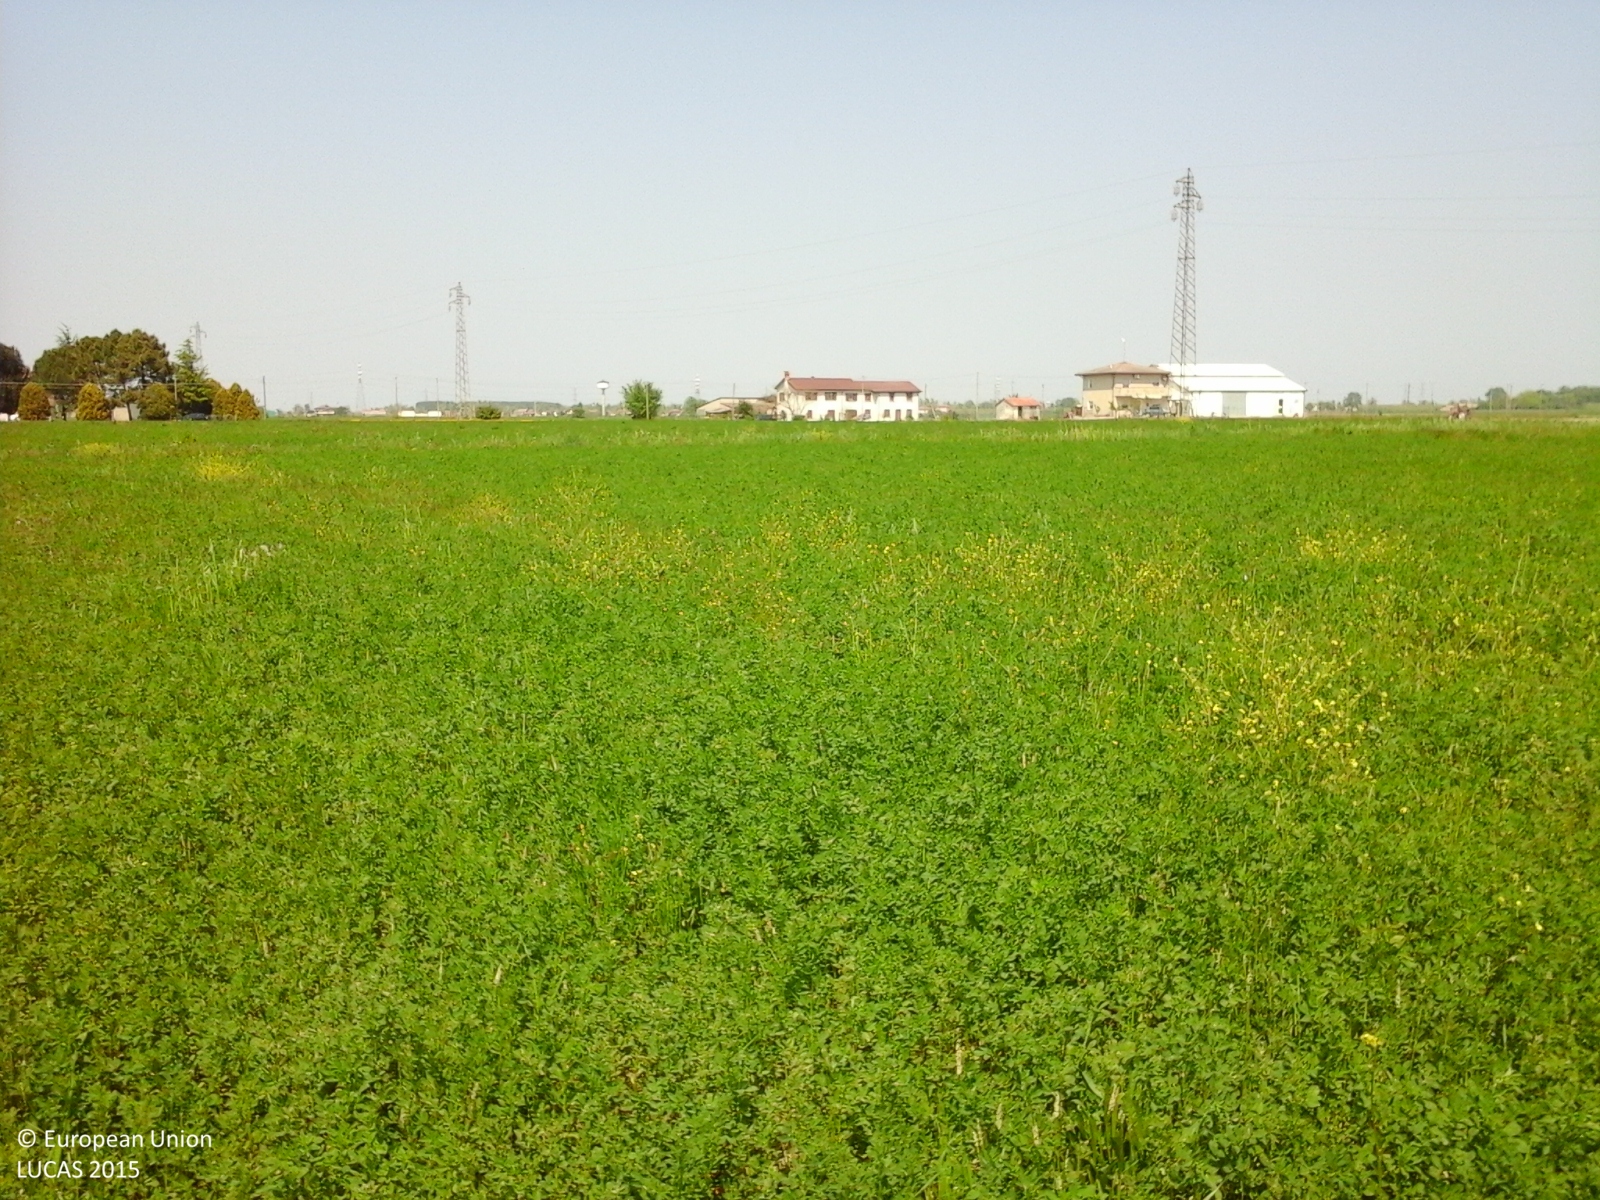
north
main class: Cropland
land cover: Lucerne
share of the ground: > 75 %
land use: Agriculture (excluding fallow land and kitchen gardens)
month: April
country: IT
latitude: 44.8840
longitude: 12.3126
